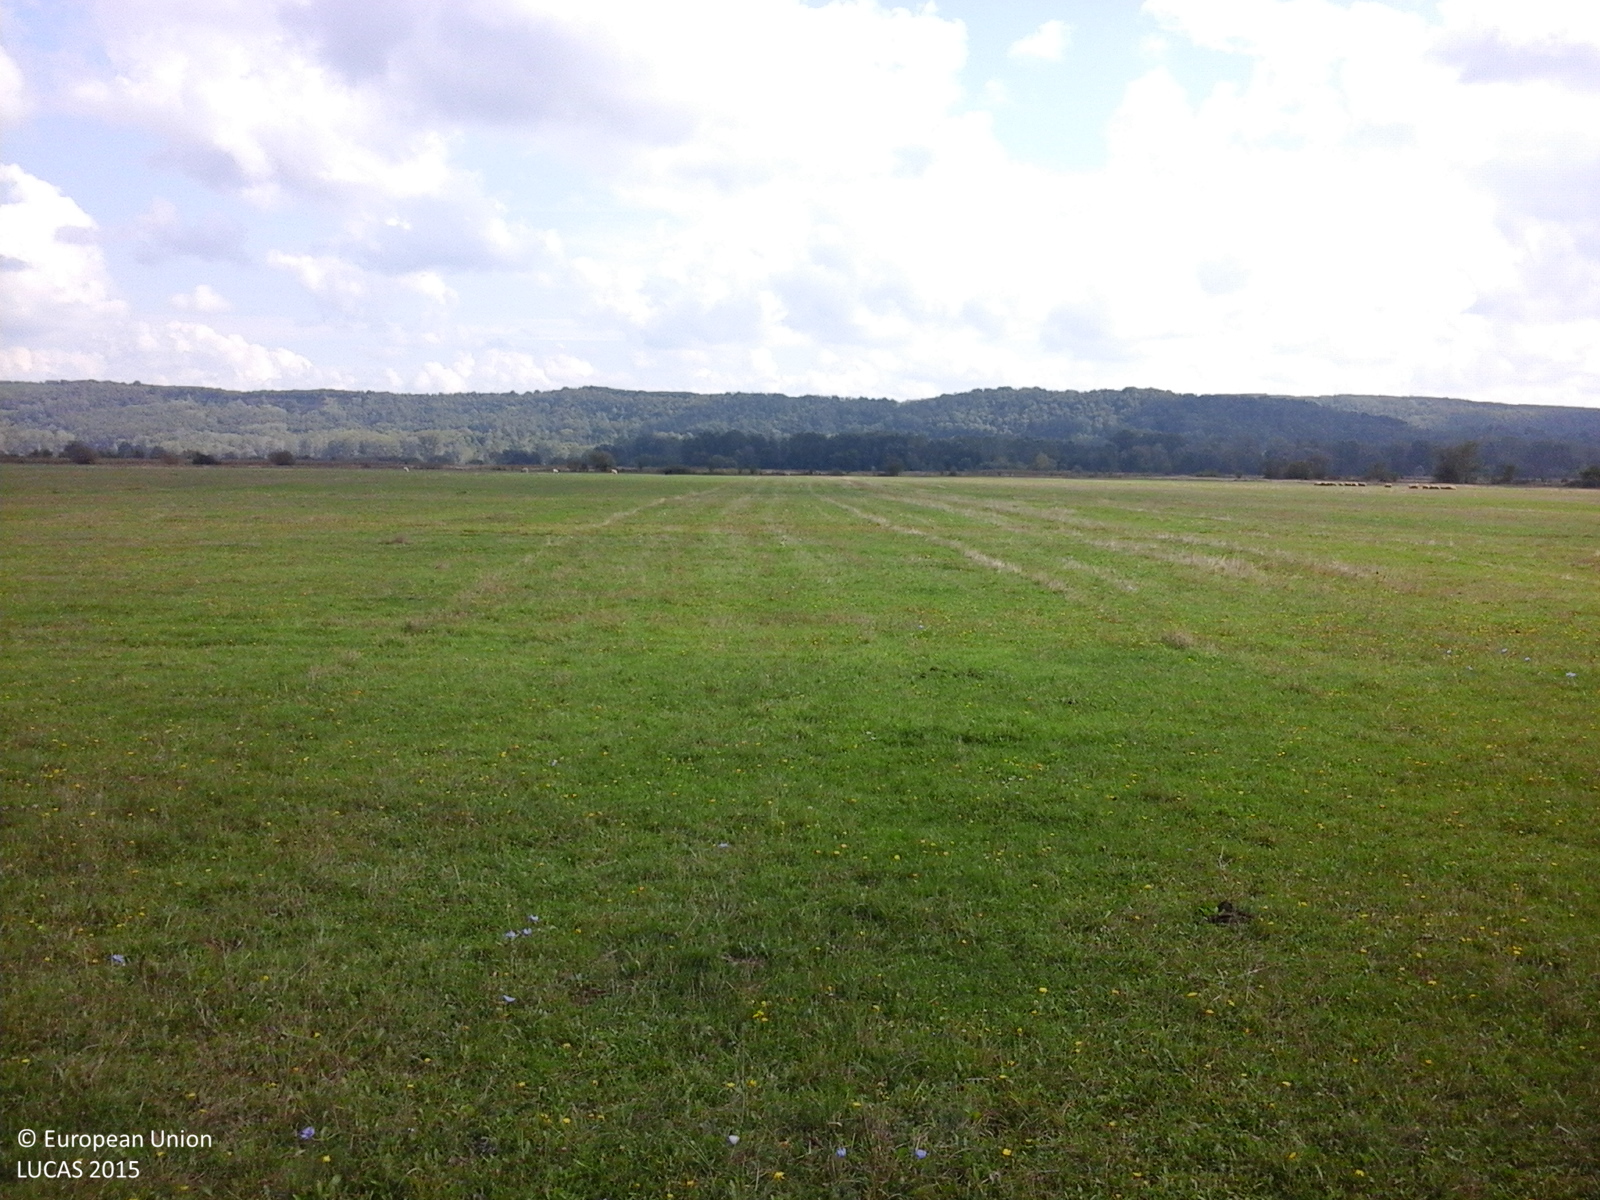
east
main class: Grassland
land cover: Grassland without tree/shrub cover
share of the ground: > 75 %
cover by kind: herbaceous plants 100 %
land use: Agriculture (excluding fallow land and kitchen gardens)
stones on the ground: < 10 %
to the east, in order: Grassland without tree/shrub cover
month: September
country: RO
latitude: 44.9924
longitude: 23.5412
